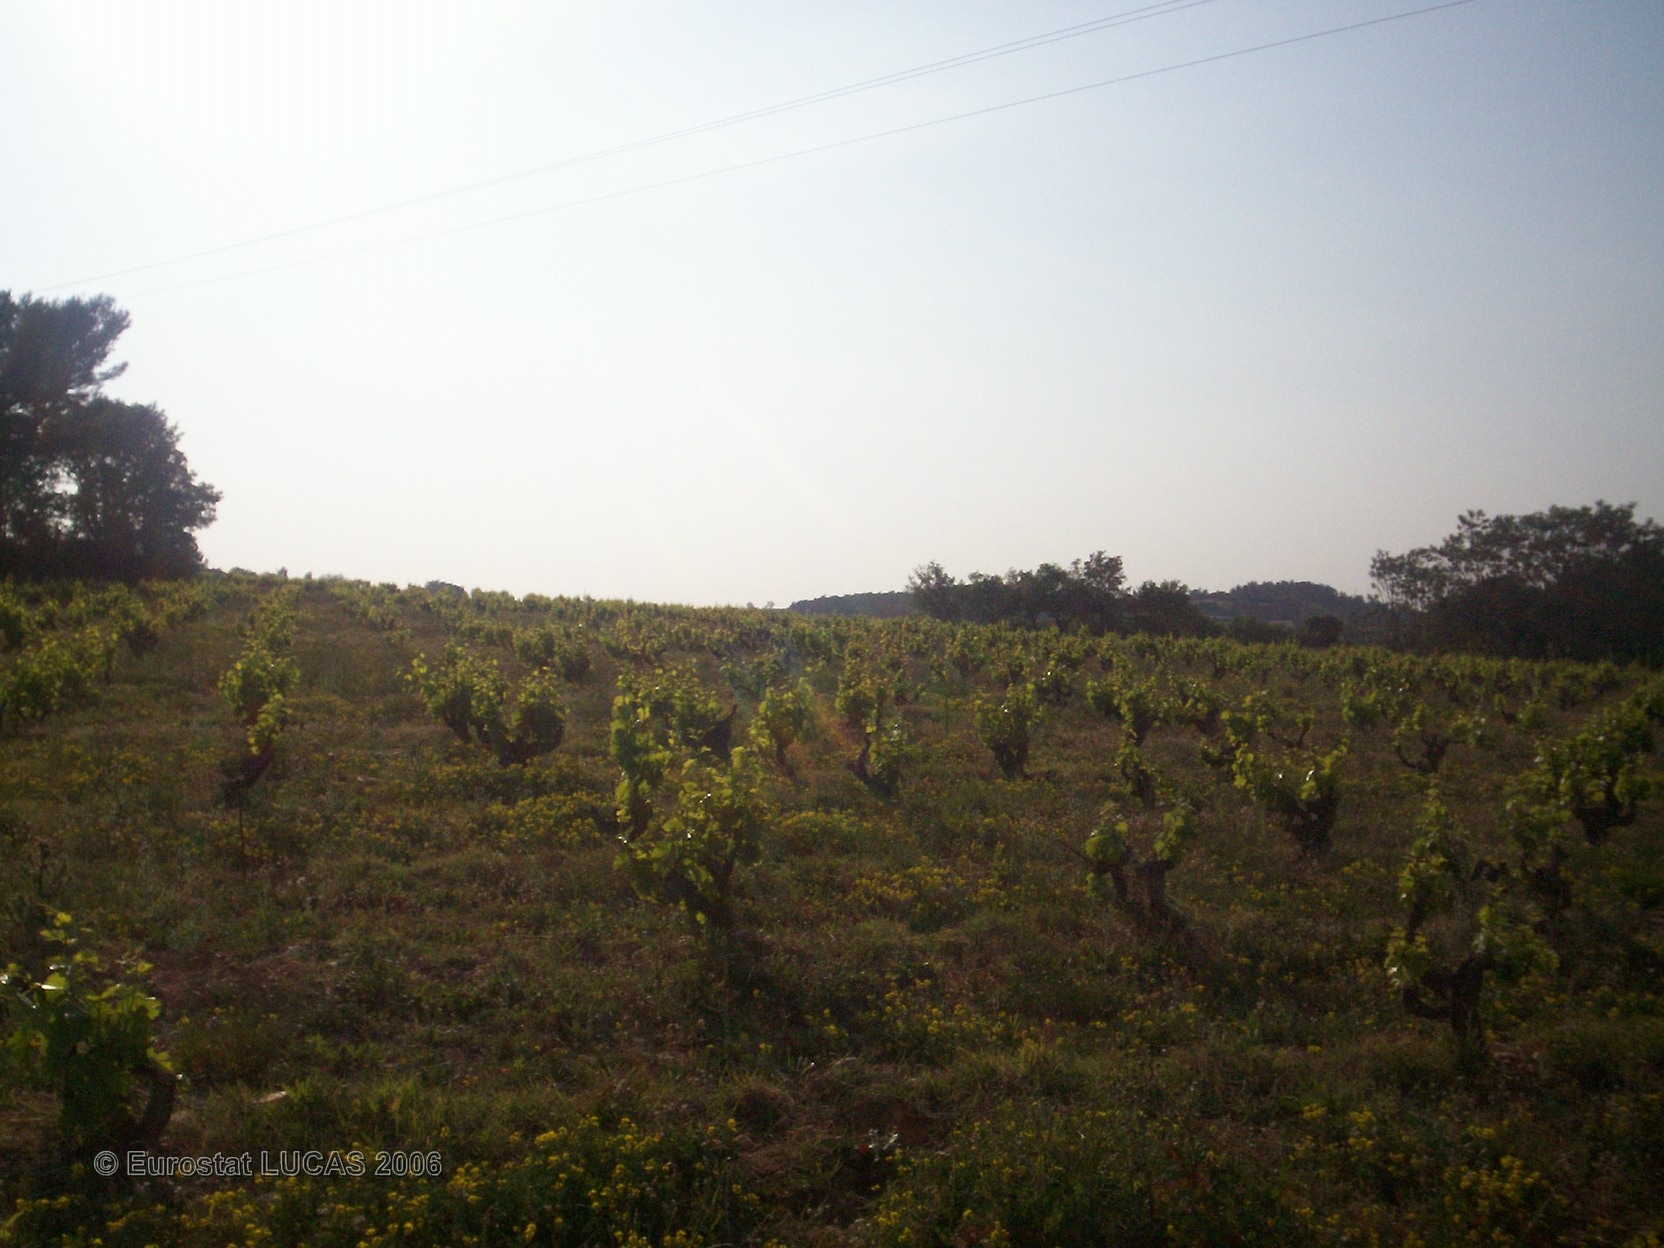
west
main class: Cropland
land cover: Vineyards
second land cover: Grassland without tree/shrub cover
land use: Agriculture (excluding fallow land and kitchen gardens)
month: May
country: FR
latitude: 44.0614
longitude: 4.8774
